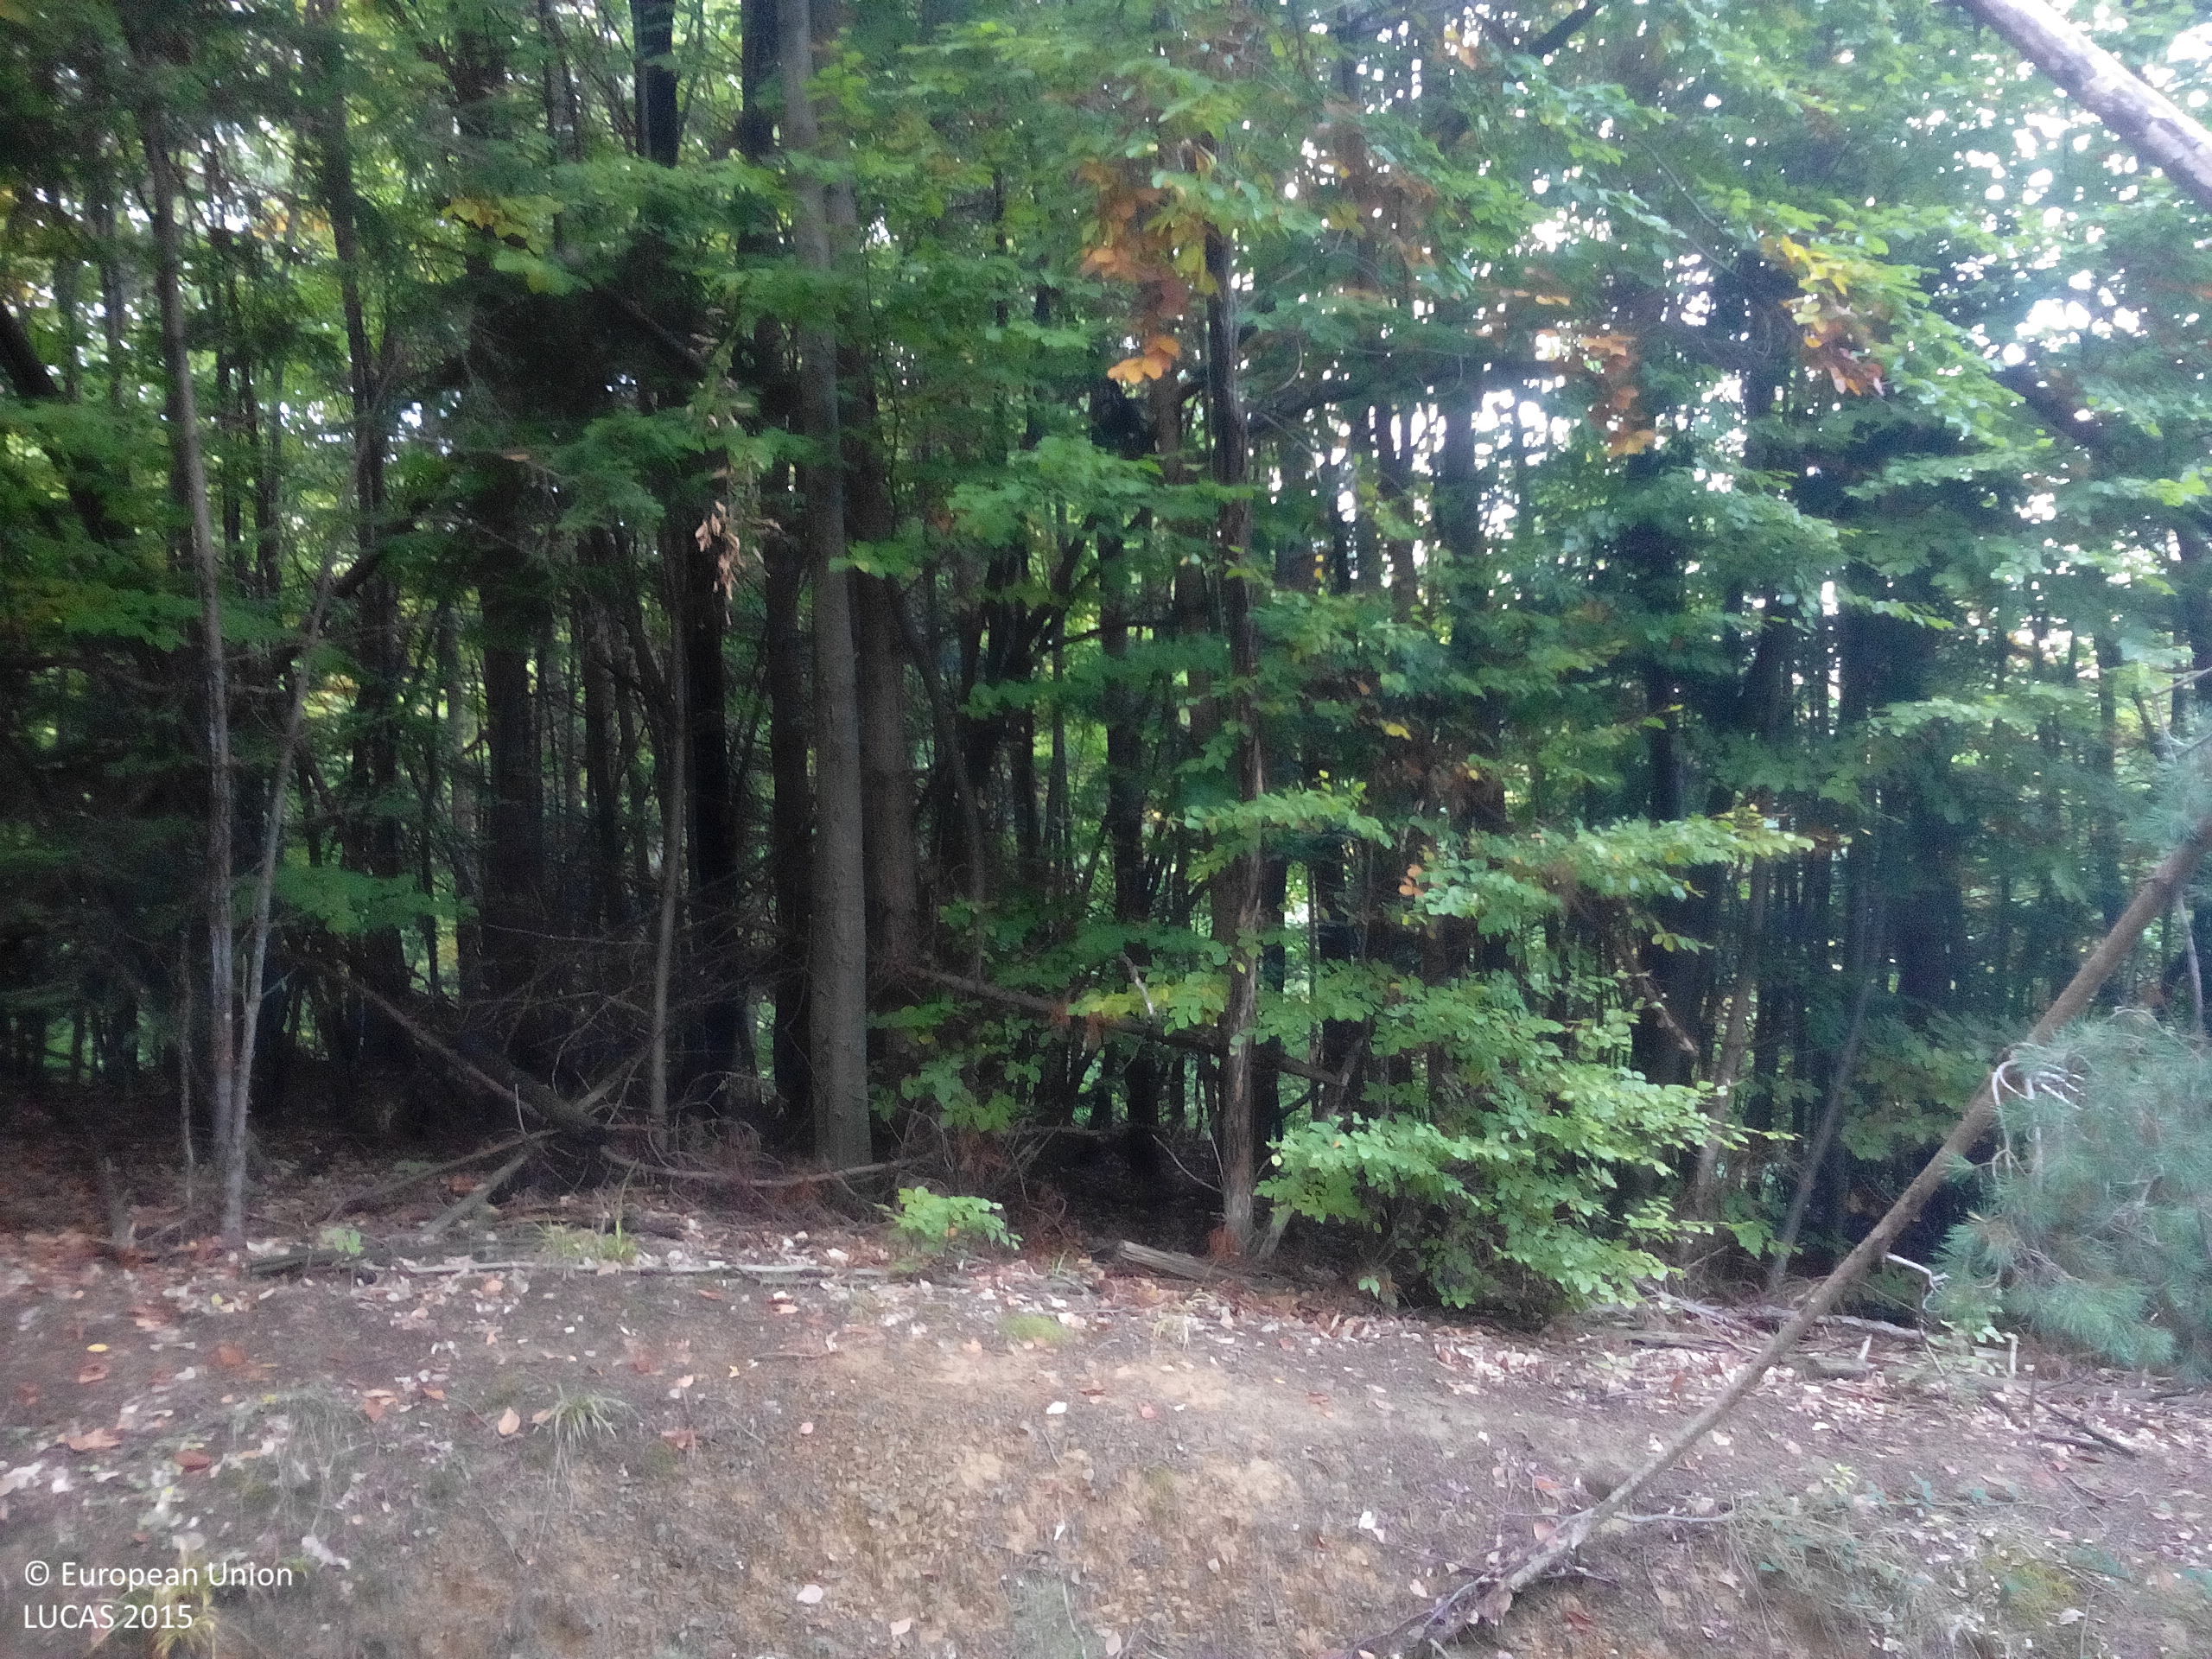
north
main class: Woodland
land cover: Pine dominated mixed woodland
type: alpine coniferous forest
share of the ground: 50 - 75 %
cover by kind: coniferous forest trees 70 %, broadleaved forest trees 25 %, shrubs 5 %
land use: Forestry
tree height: > 5 m
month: October
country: BG
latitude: 42.8444
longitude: 24.2813
